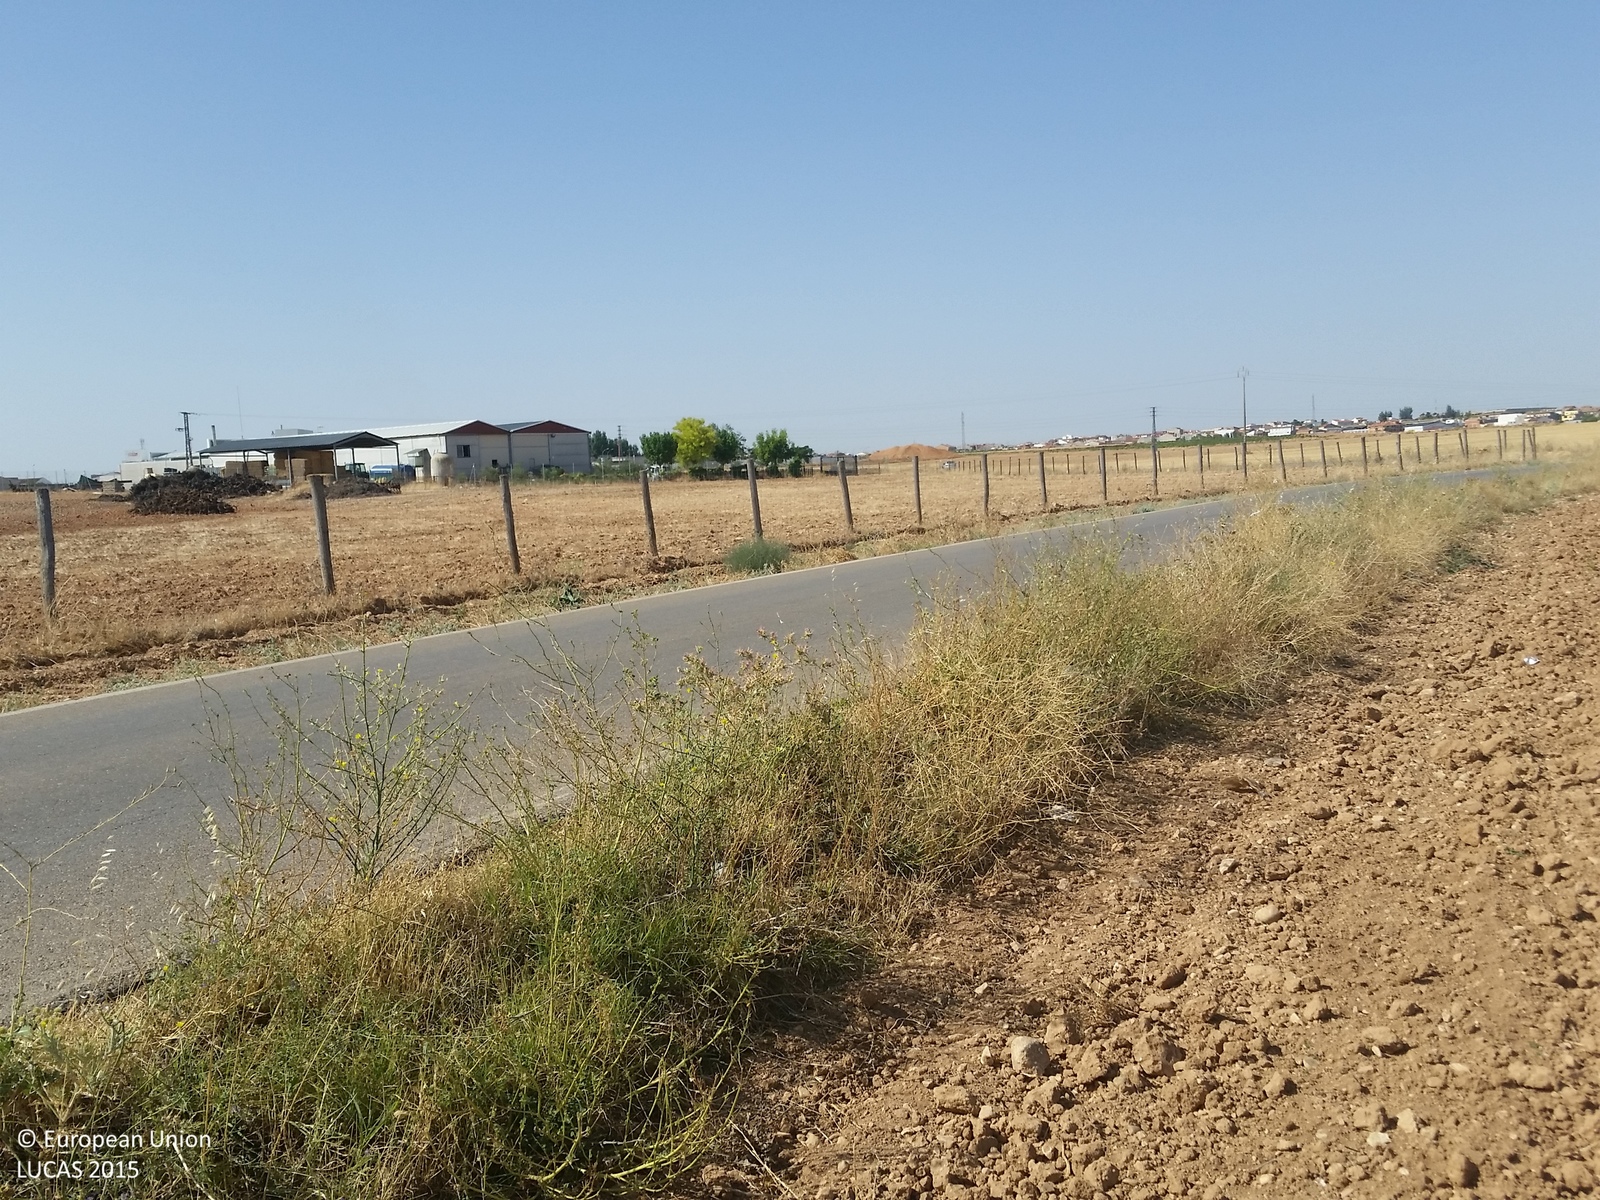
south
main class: Cropland
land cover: Vineyards
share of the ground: 50 - 75 %
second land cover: Other bare soil
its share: > 75 %
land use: Agriculture (excluding fallow land and kitchen gardens)
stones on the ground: 10 - 25 %
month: July
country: ES
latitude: 39.2882
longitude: -2.5896
